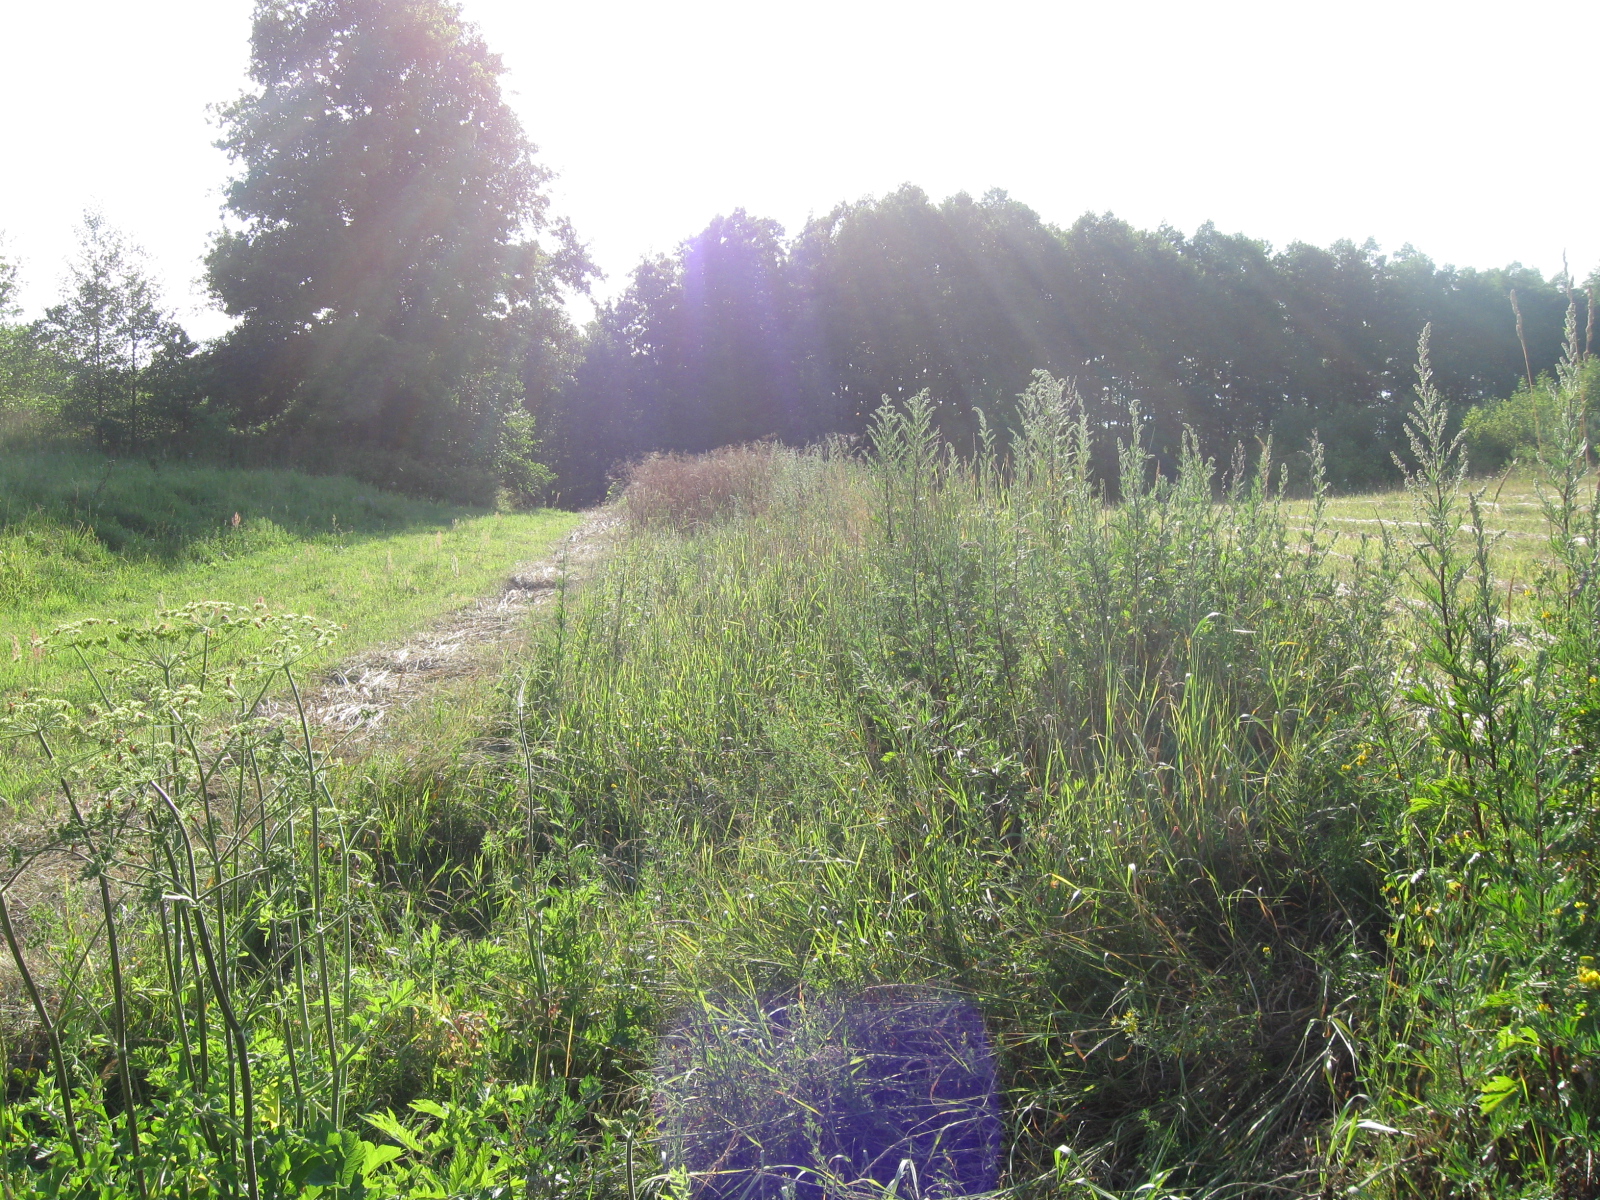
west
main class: Grassland
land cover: Spontaneously vegetated surfaces
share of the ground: > 75 %
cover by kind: herbaceous plants 100 %
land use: Agriculture (excluding fallow land and kitchen gardens)
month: July
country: LT
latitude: 54.4549
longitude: 24.3993
